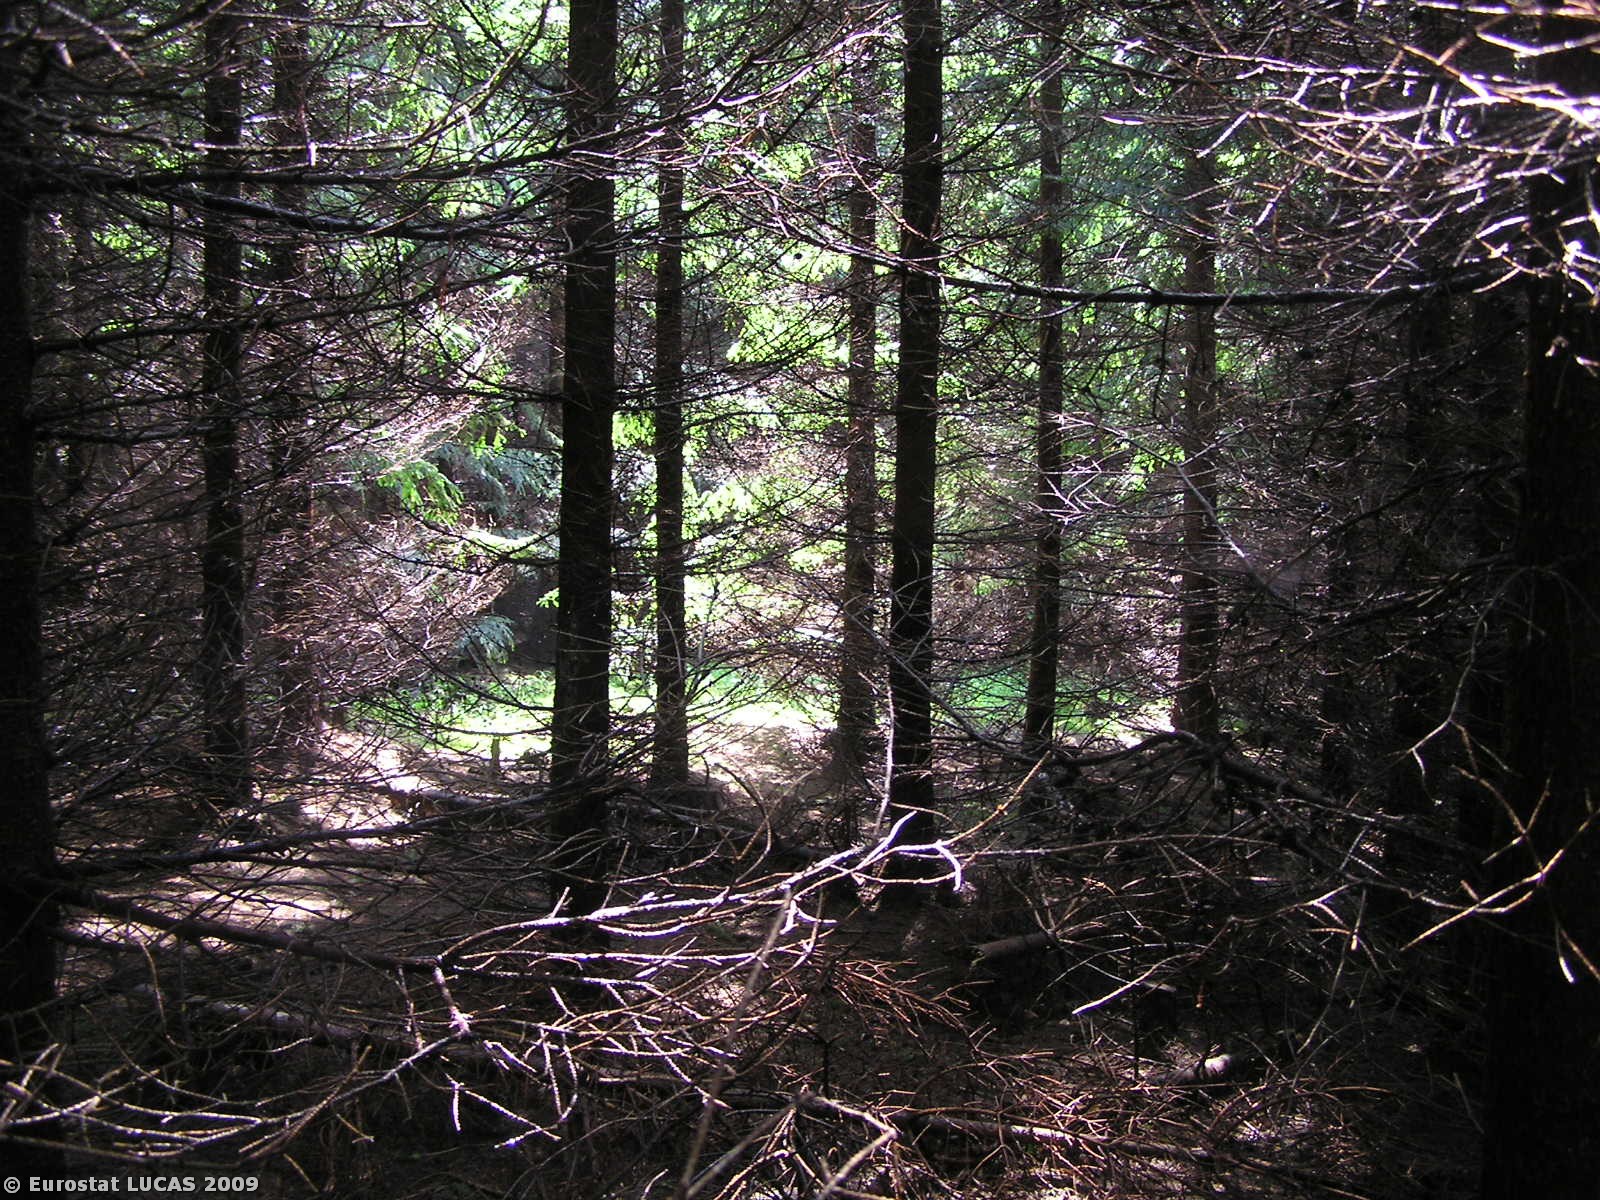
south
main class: Woodland
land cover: Coniferous woodland
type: hemiboreal forest and nemoral coniferous forest and mixed broadleaved-coniferous forest
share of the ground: > 75 %
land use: Forestry
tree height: > 5 m
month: June
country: CZ
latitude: 50.2110
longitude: 17.4530
